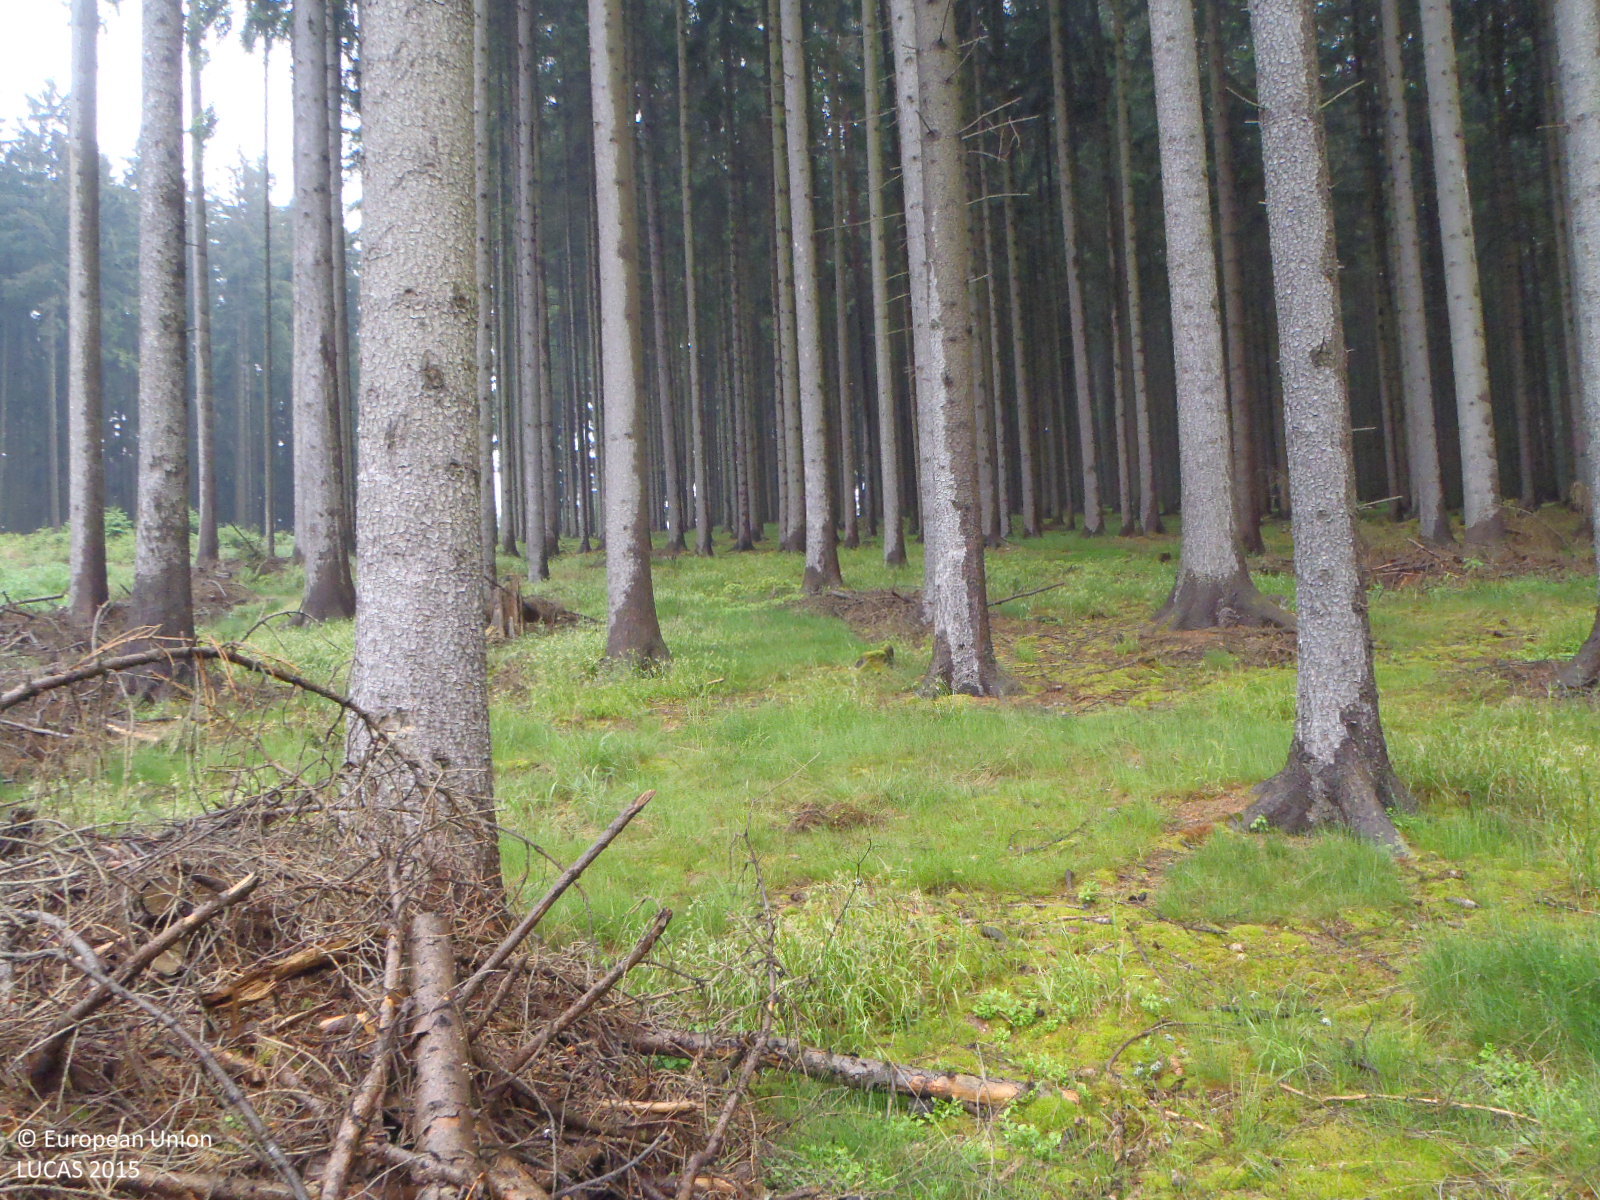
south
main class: Woodland
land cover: Spruce dominated coniferous woodland
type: hemiboreal forest and nemoral coniferous forest and mixed broadleaved-coniferous forest
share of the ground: 25 - 50 %
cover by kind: coniferous forest trees 40 %, herbaceous plants 35 %, shrubs 10 %, lichens and mosses 10 %, broadleaved forest trees 5 %
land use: Forestry
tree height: < 5 m
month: May
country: CZ
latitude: 48.8047
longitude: 14.3441
